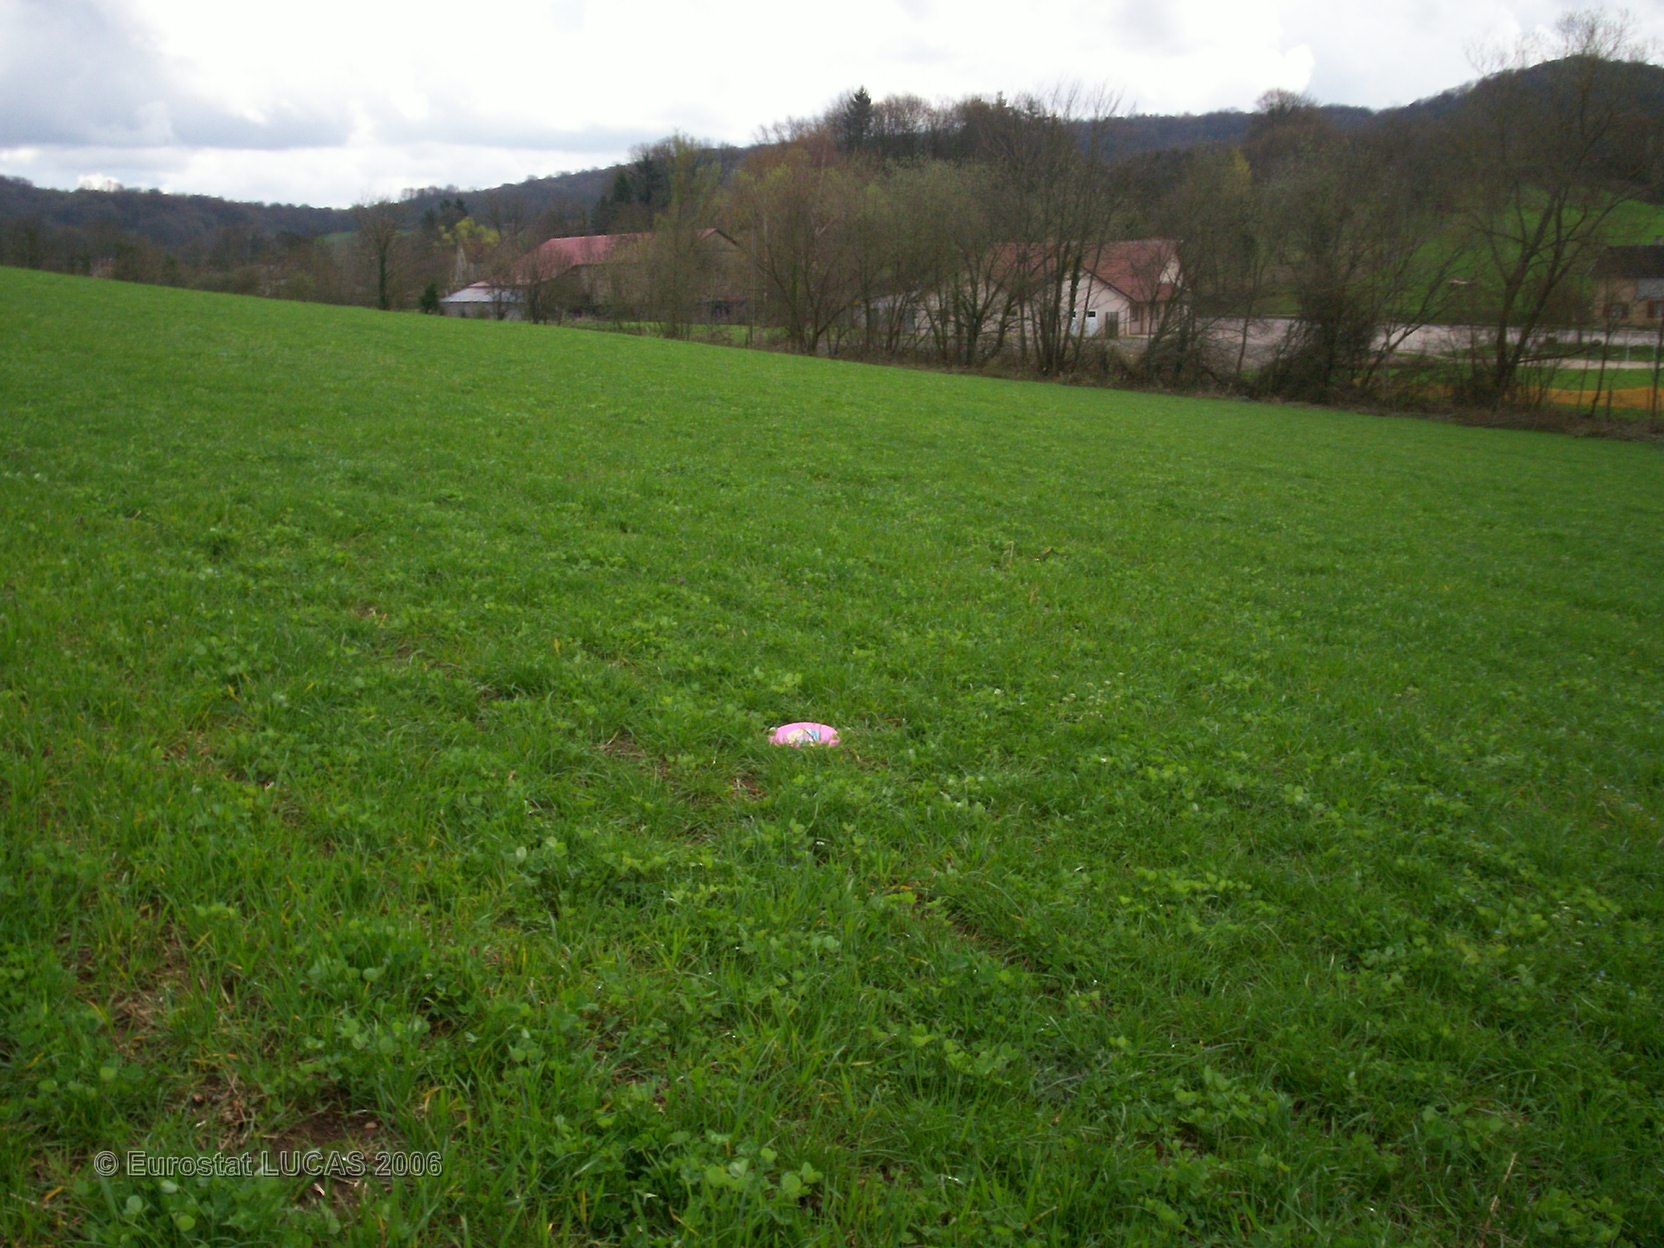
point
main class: Cropland
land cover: Other leguminous and mixtures for fodder
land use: Agriculture (excluding fallow land and kitchen gardens)
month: April
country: FR
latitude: 47.5206
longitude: 6.5354
